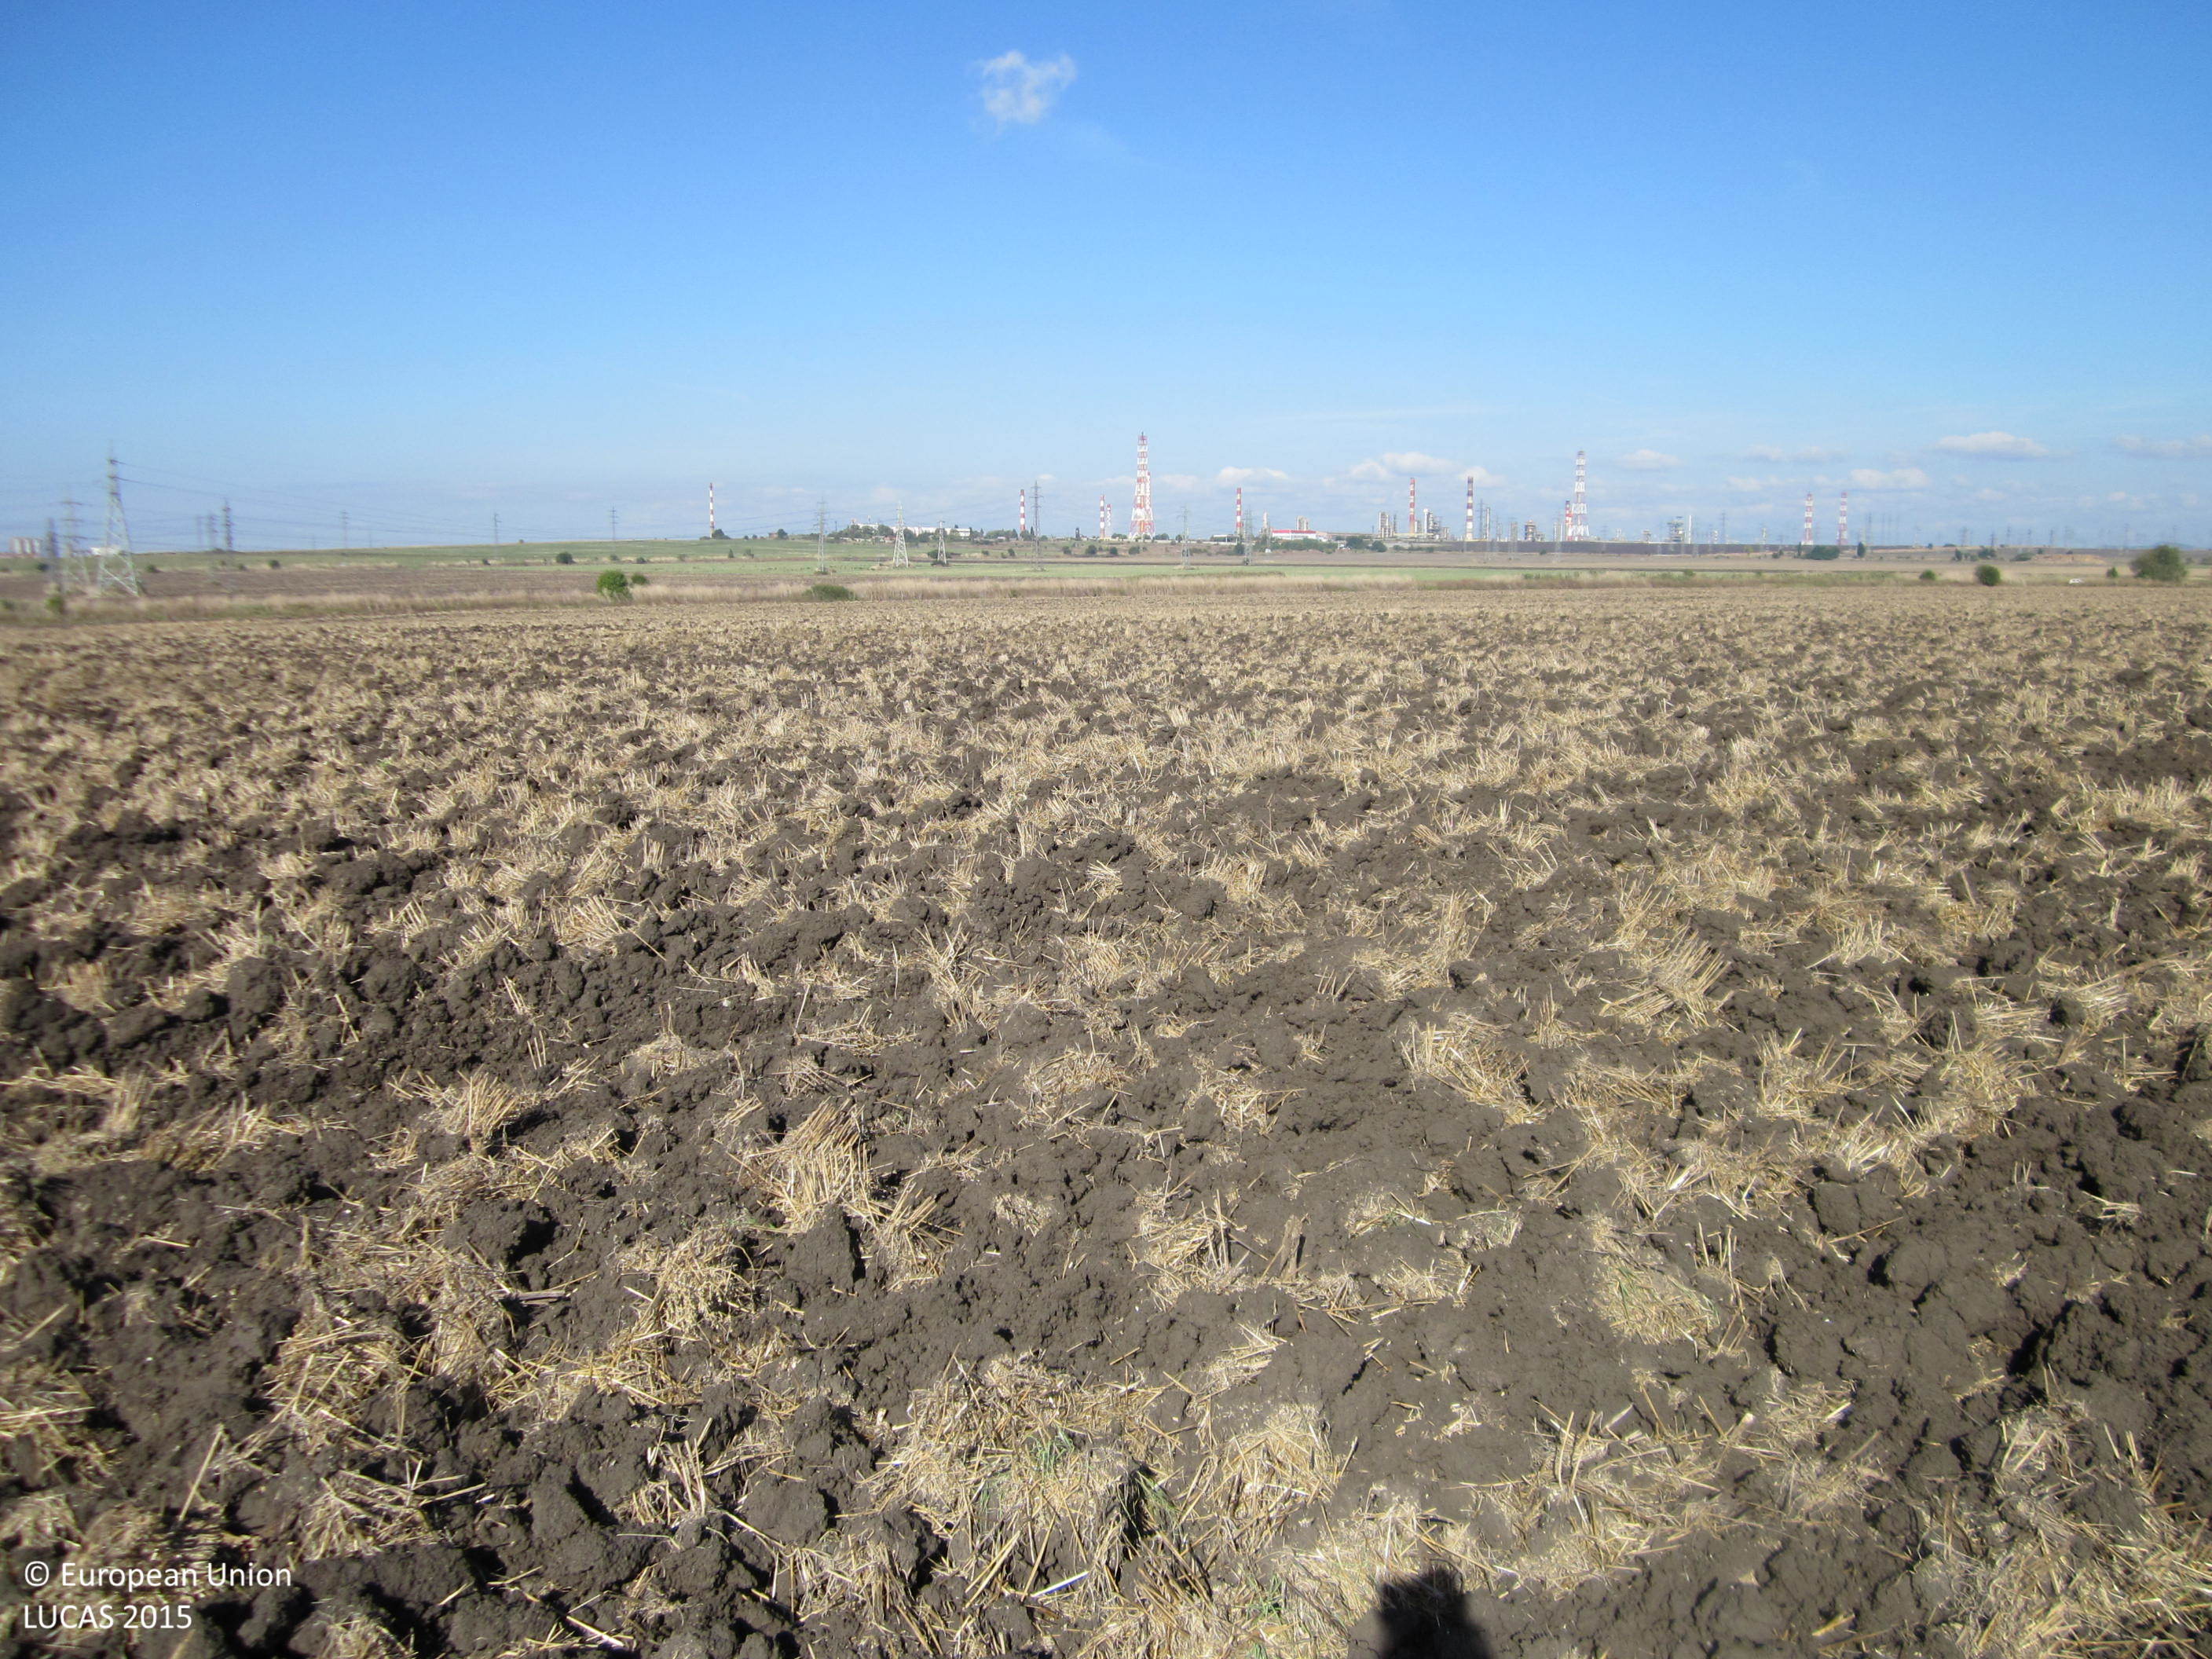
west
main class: Cropland
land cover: Common wheat
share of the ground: < 10 %
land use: Agriculture (excluding fallow land and kitchen gardens)
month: September
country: BG
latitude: 42.5404
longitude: 27.3687
